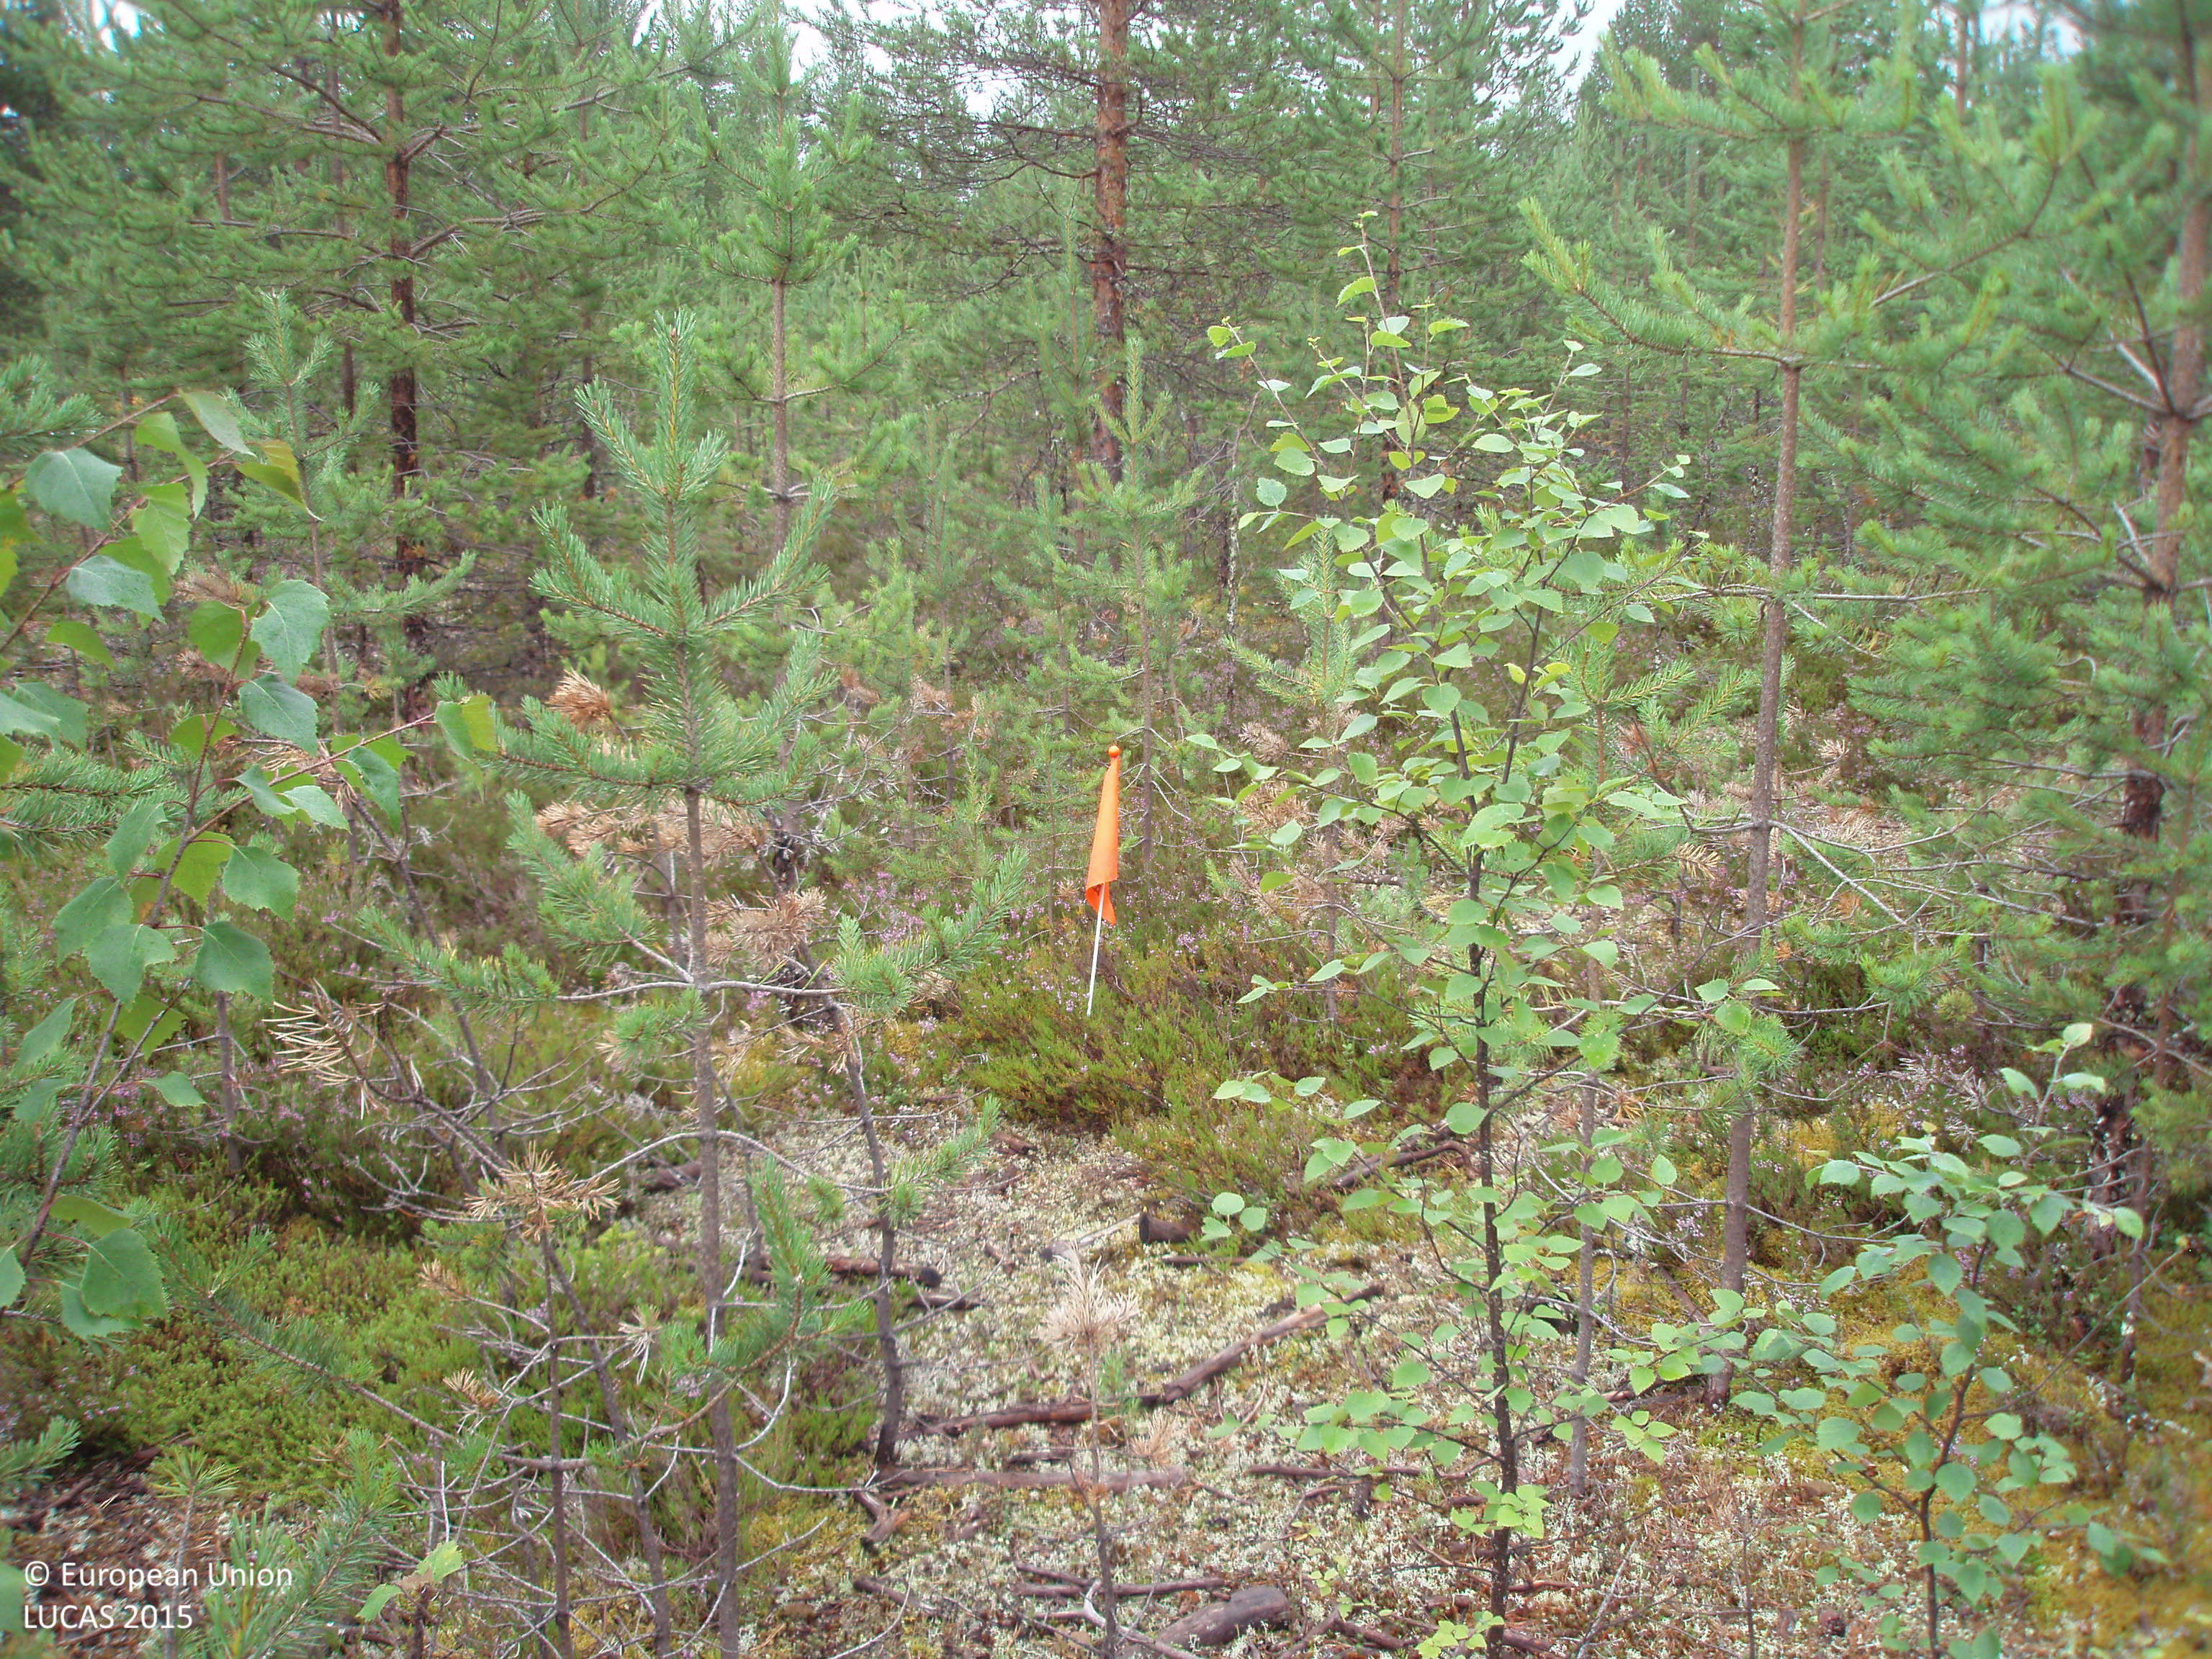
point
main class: Woodland
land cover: Pine dominated coniferous woodland
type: boreal forest
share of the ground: 25 - 50 %
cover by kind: shrubs 60 %, coniferous forest trees 40 %
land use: Forestry
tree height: < 5 m
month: August
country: FI
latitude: 65.5889
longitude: 27.0063
